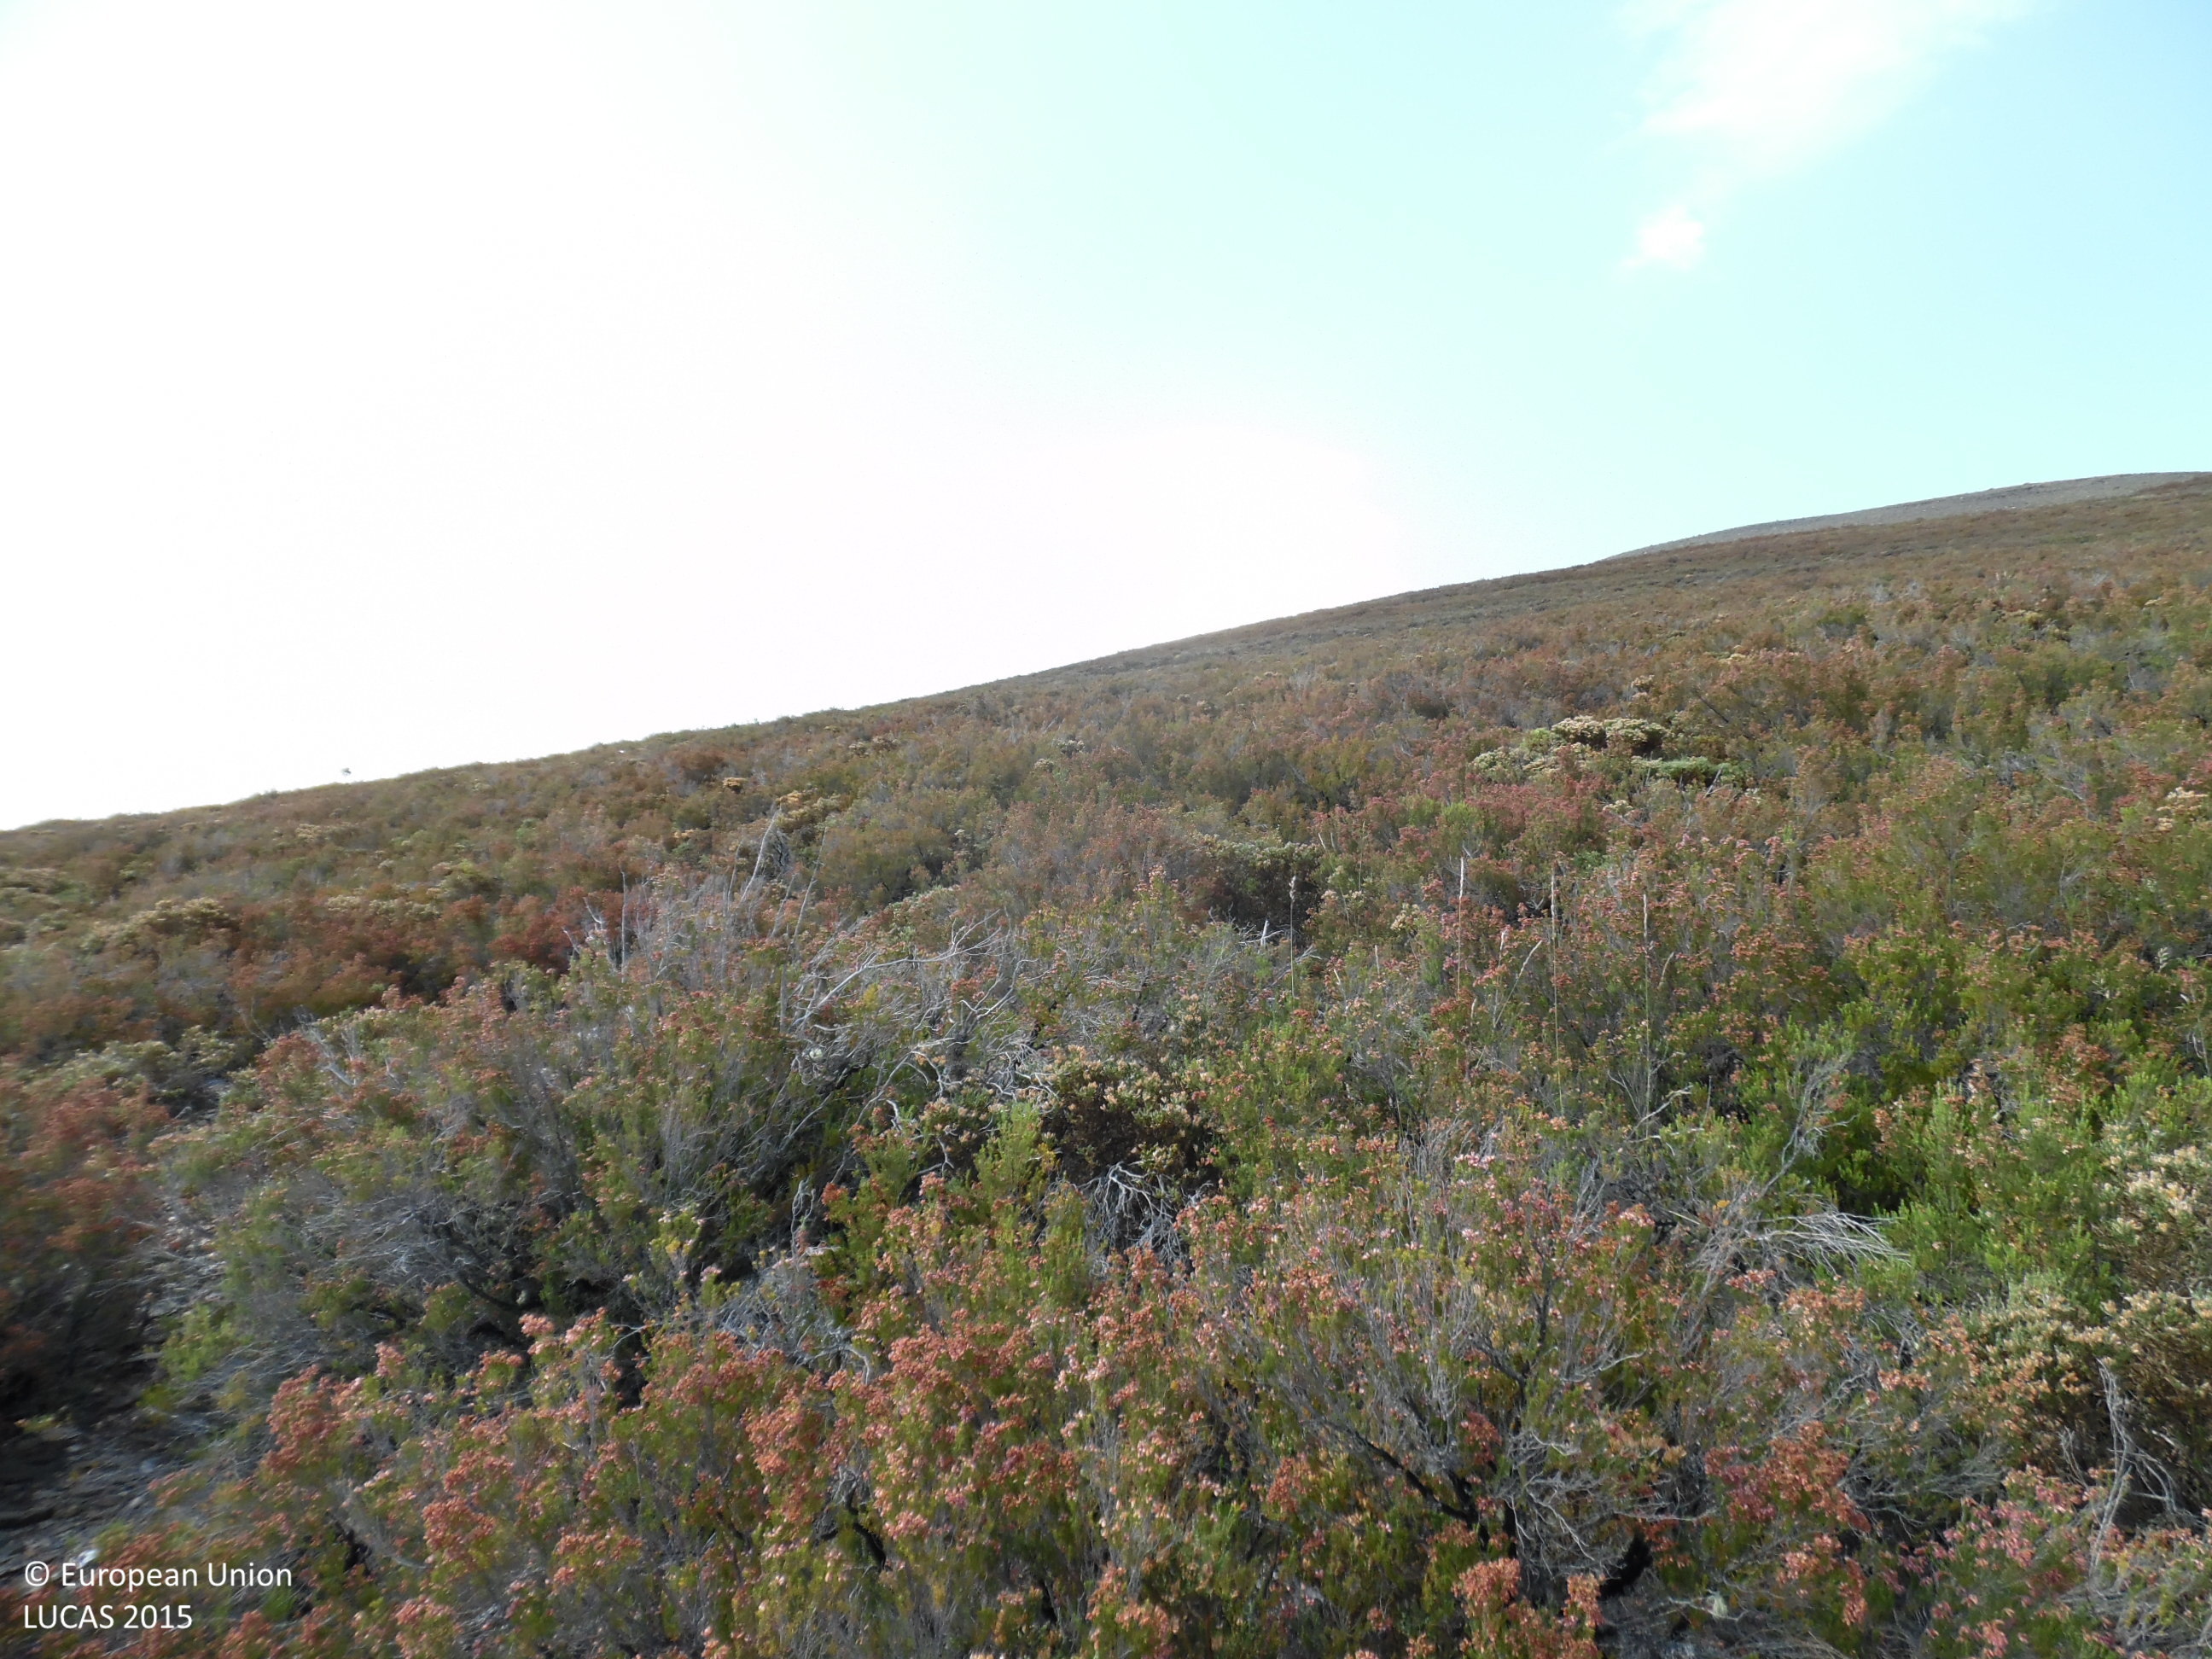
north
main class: Shrubland
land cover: Shrubland without tree cover
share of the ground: > 75 %
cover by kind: shrubs 90 %, unconsolidated bare surface 10 %
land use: Semi-natural and natural areas not in use
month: June
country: ES
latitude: 42.2642
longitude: -6.3922
